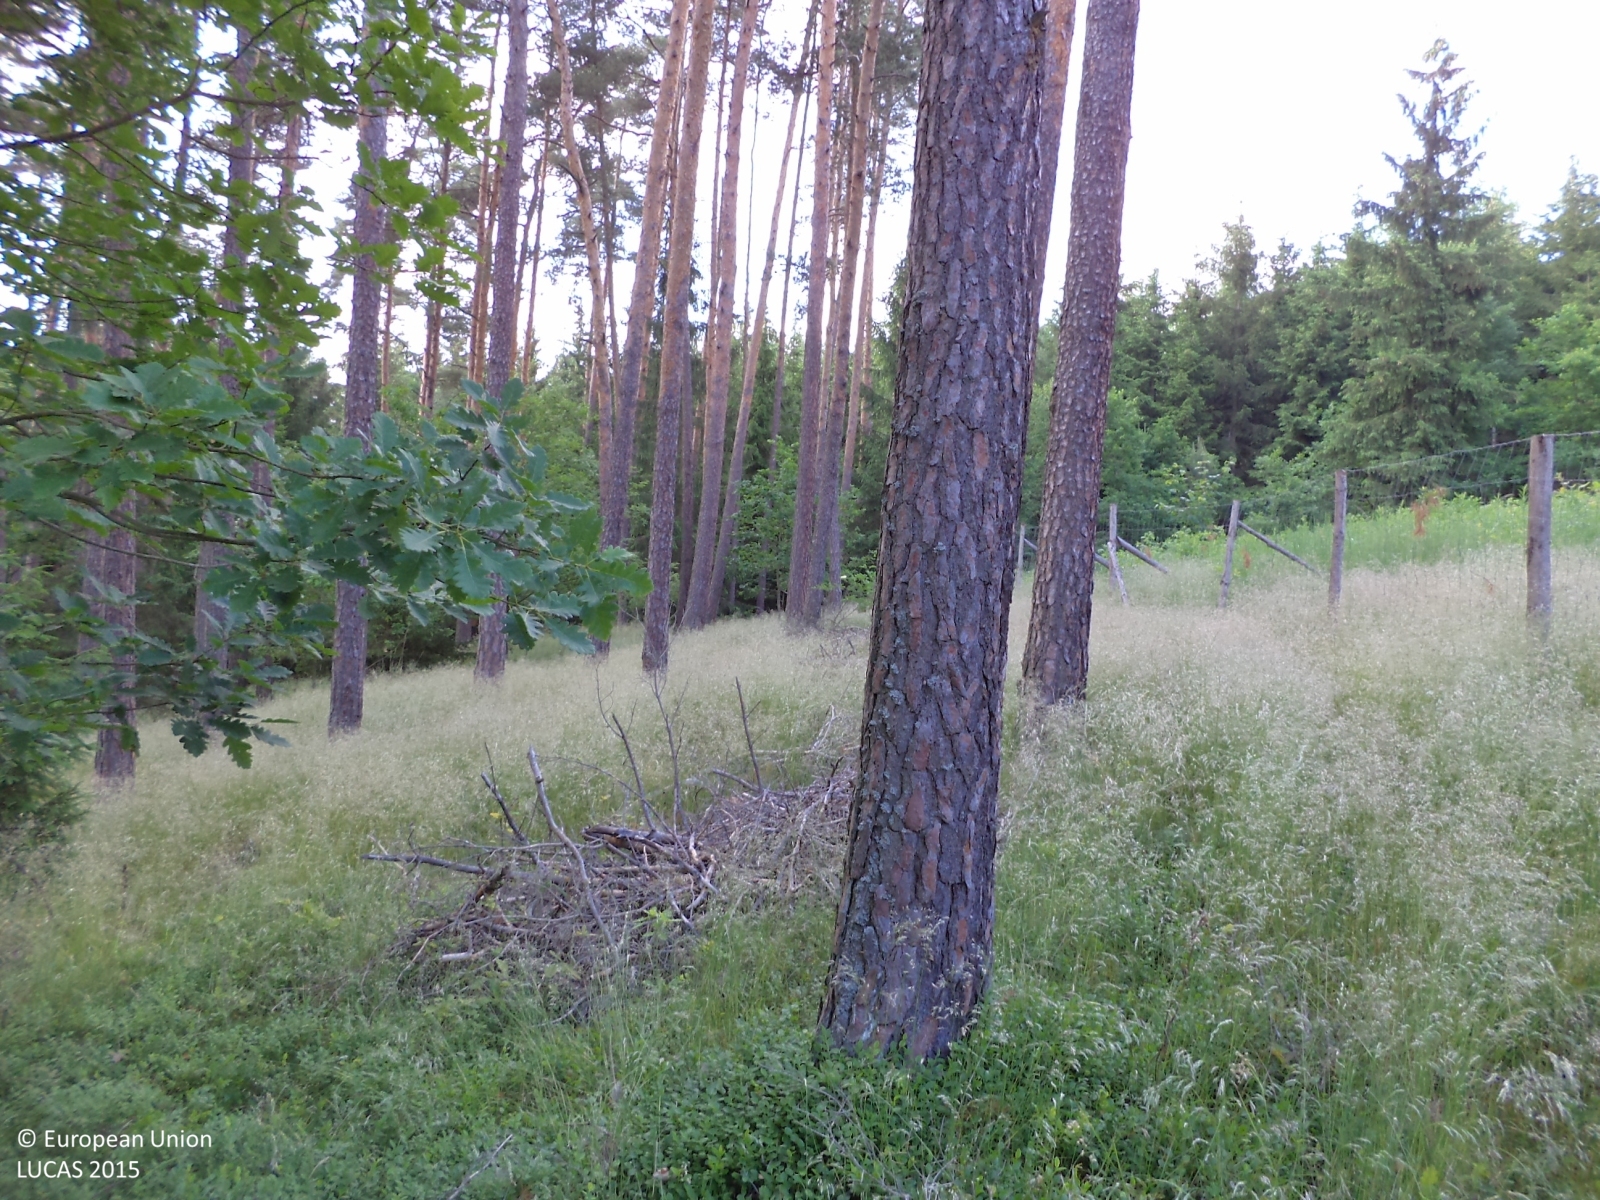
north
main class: Woodland
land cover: Pine dominated coniferous woodland
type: hemiboreal forest and nemoral coniferous forest and mixed broadleaved-coniferous forest
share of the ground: > 75 %
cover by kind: coniferous forest trees 70 %, herbaceous plants 25 %, broadleaved forest trees 5 %
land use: Forestry
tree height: > 5 m
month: June
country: CZ
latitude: 49.2725
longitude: 14.3580
